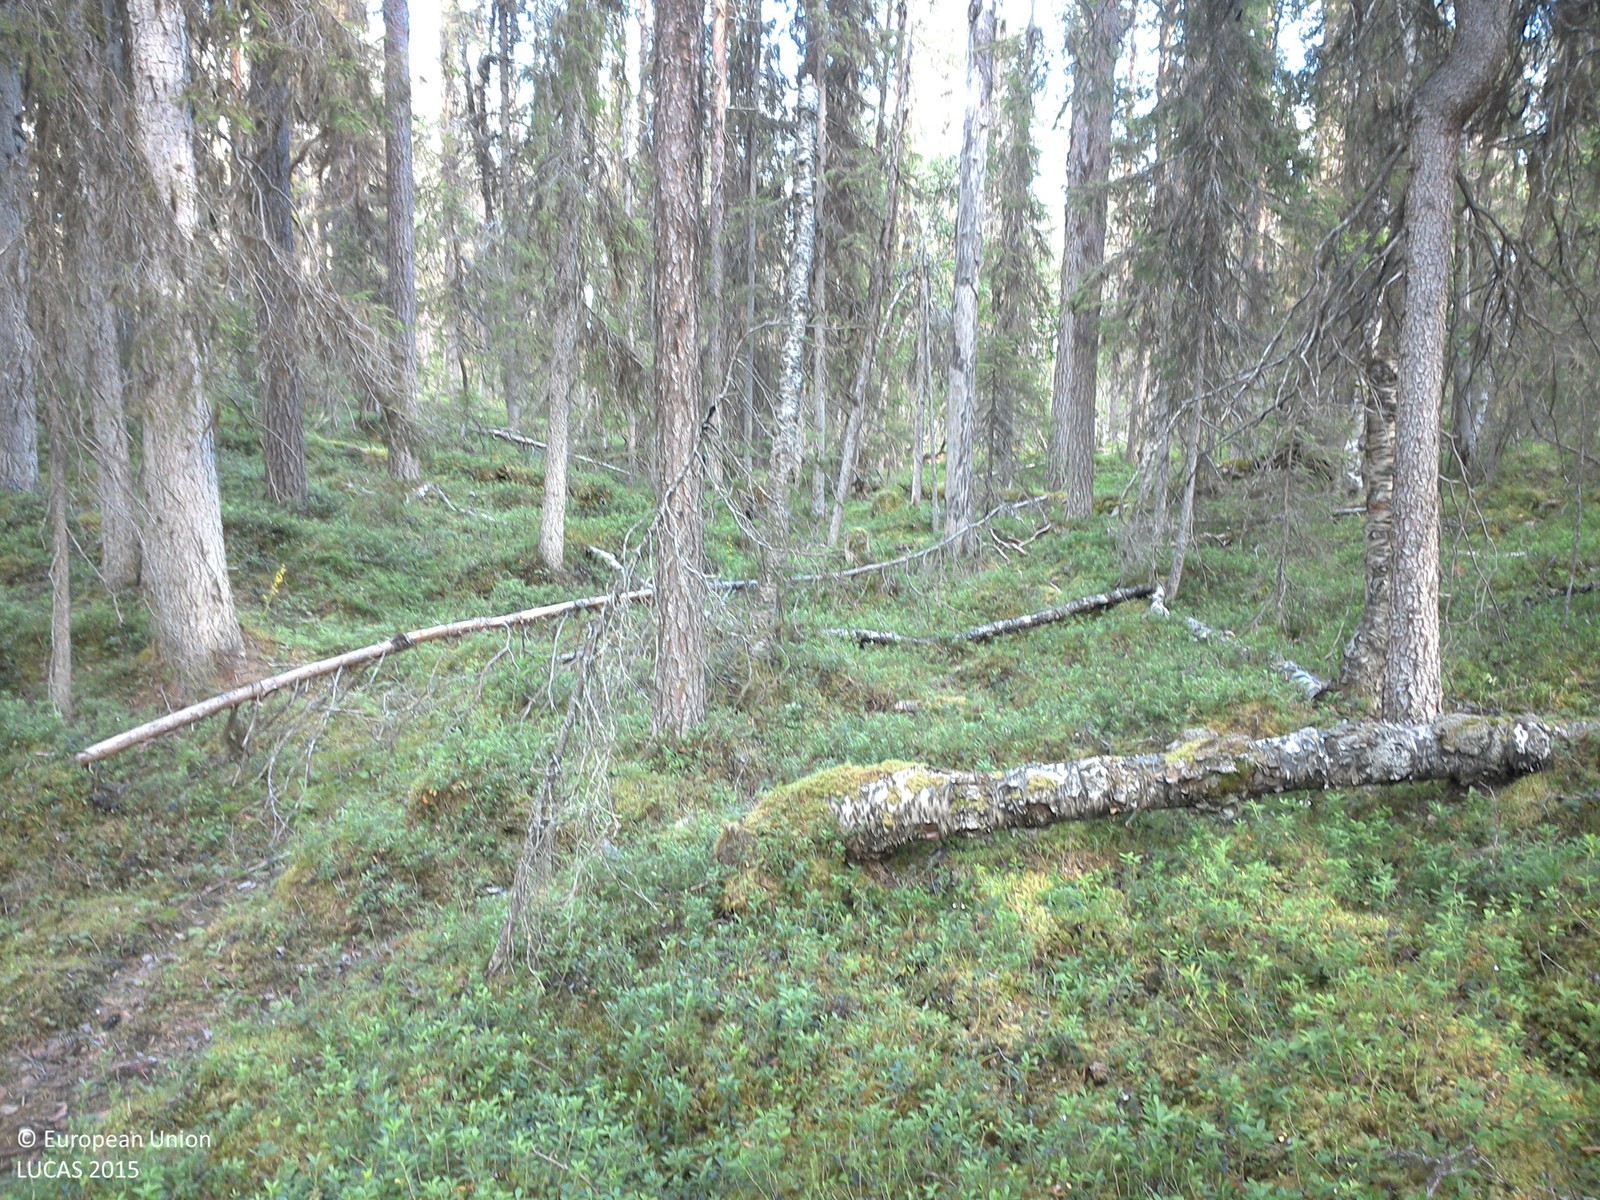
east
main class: Woodland
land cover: Spruce dominated coniferous woodland
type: boreal forest
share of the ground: 25 - 50 %
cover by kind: shrubs 55 %, coniferous forest trees 40 %, lichens and mosses 5 %
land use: Forestry
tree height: > 5 m
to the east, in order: Spruce dominated coniferous woodland; Pine dominated coniferous woodland; Rivers and streams; Groves; Rivers and streams; Pine dominated coniferous woodland
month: August
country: SE
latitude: 67.7432
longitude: 21.0872
